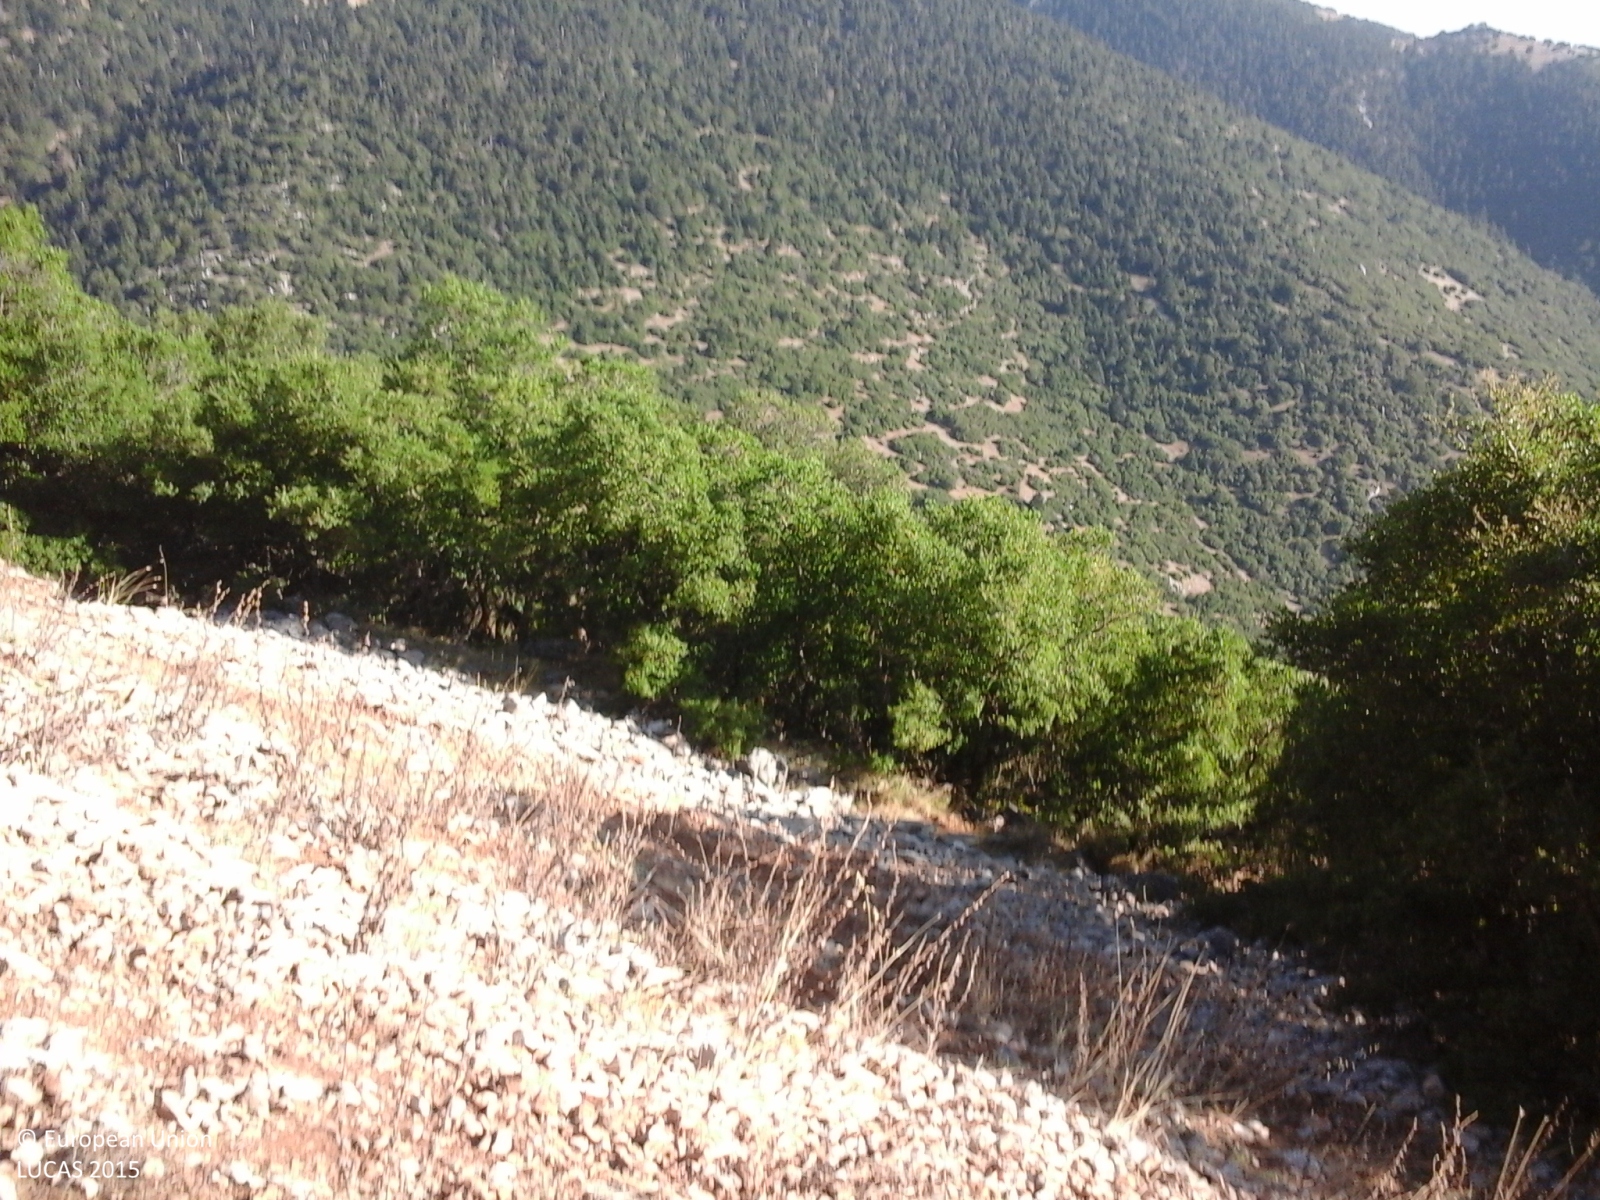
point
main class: Shrubland
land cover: Shrubland without tree cover
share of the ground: > 75 %
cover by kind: shrubs 85 %, unconsolidated bare surface 10 %, herbaceous plants 5 %
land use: Agriculture (excluding fallow land and kitchen gardens)
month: September
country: GR
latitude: 38.4723
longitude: 22.2496
